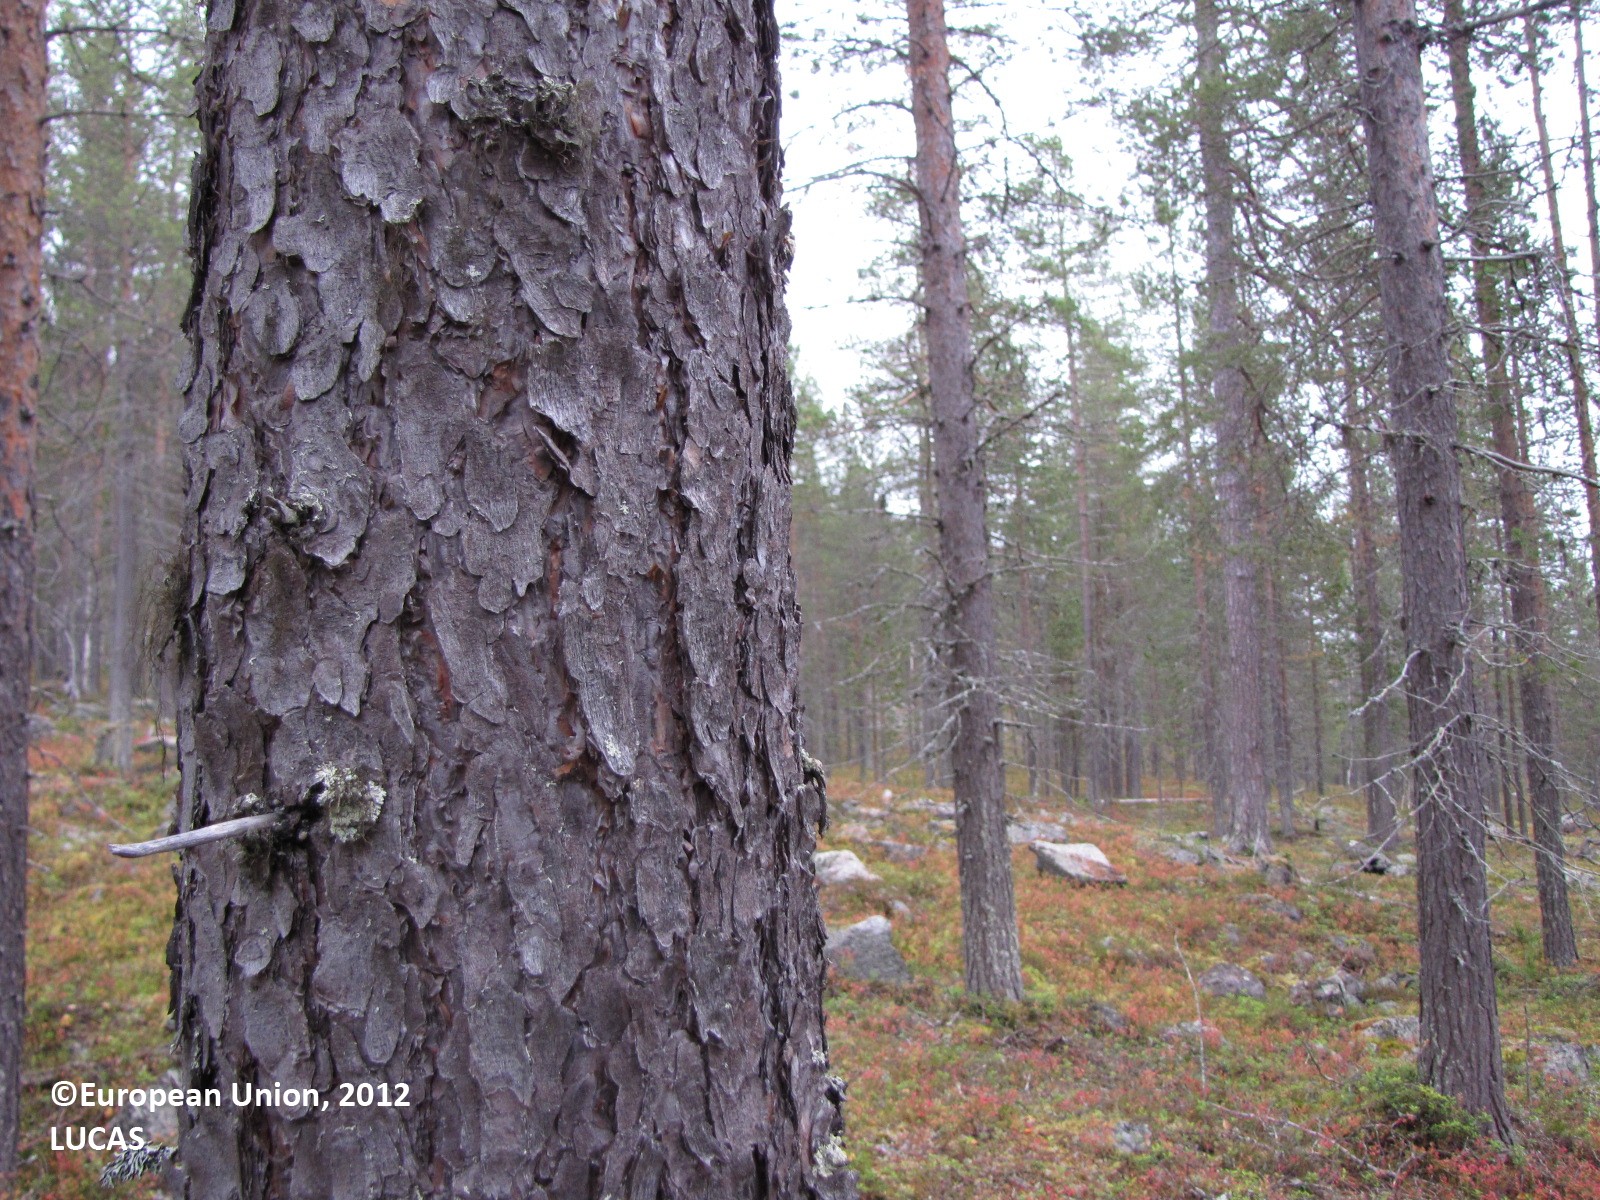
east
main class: Woodland
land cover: Pine dominated coniferous woodland
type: boreal forest
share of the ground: 25 - 50 %
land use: Forestry
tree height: > 5 m
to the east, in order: Pine dominated coniferous woodland; Rocks and stones; Rivers and streams; Rocks and stones; Grassland without tree/shrub cover
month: September
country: FI
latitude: 67.5868
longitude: 24.0534
